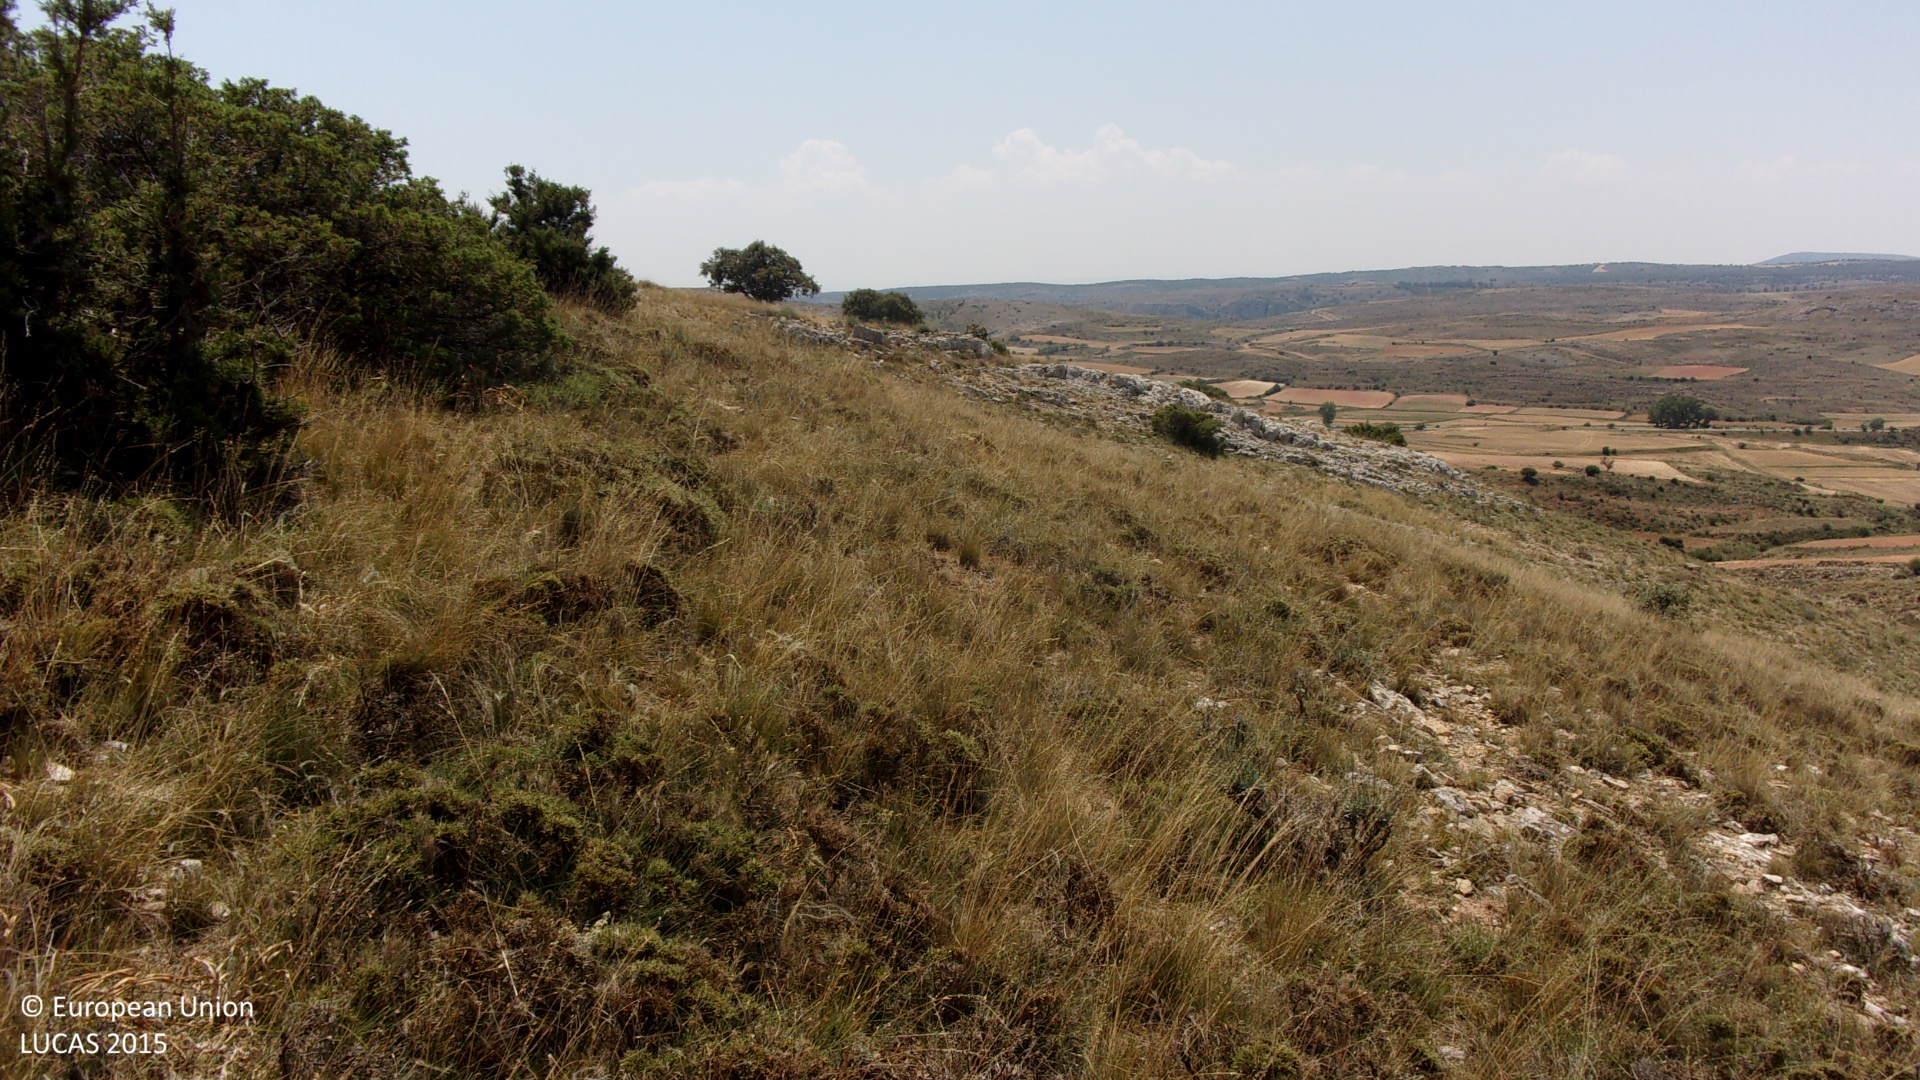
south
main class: Shrubland
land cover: Shrubland without tree cover
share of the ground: > 75 %
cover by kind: shrubs 65 %, consolidated bare surface 20 %, herbaceous plants 15 %
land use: Semi-natural and natural areas not in use
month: July
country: ES
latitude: 41.5830
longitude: -1.9171
